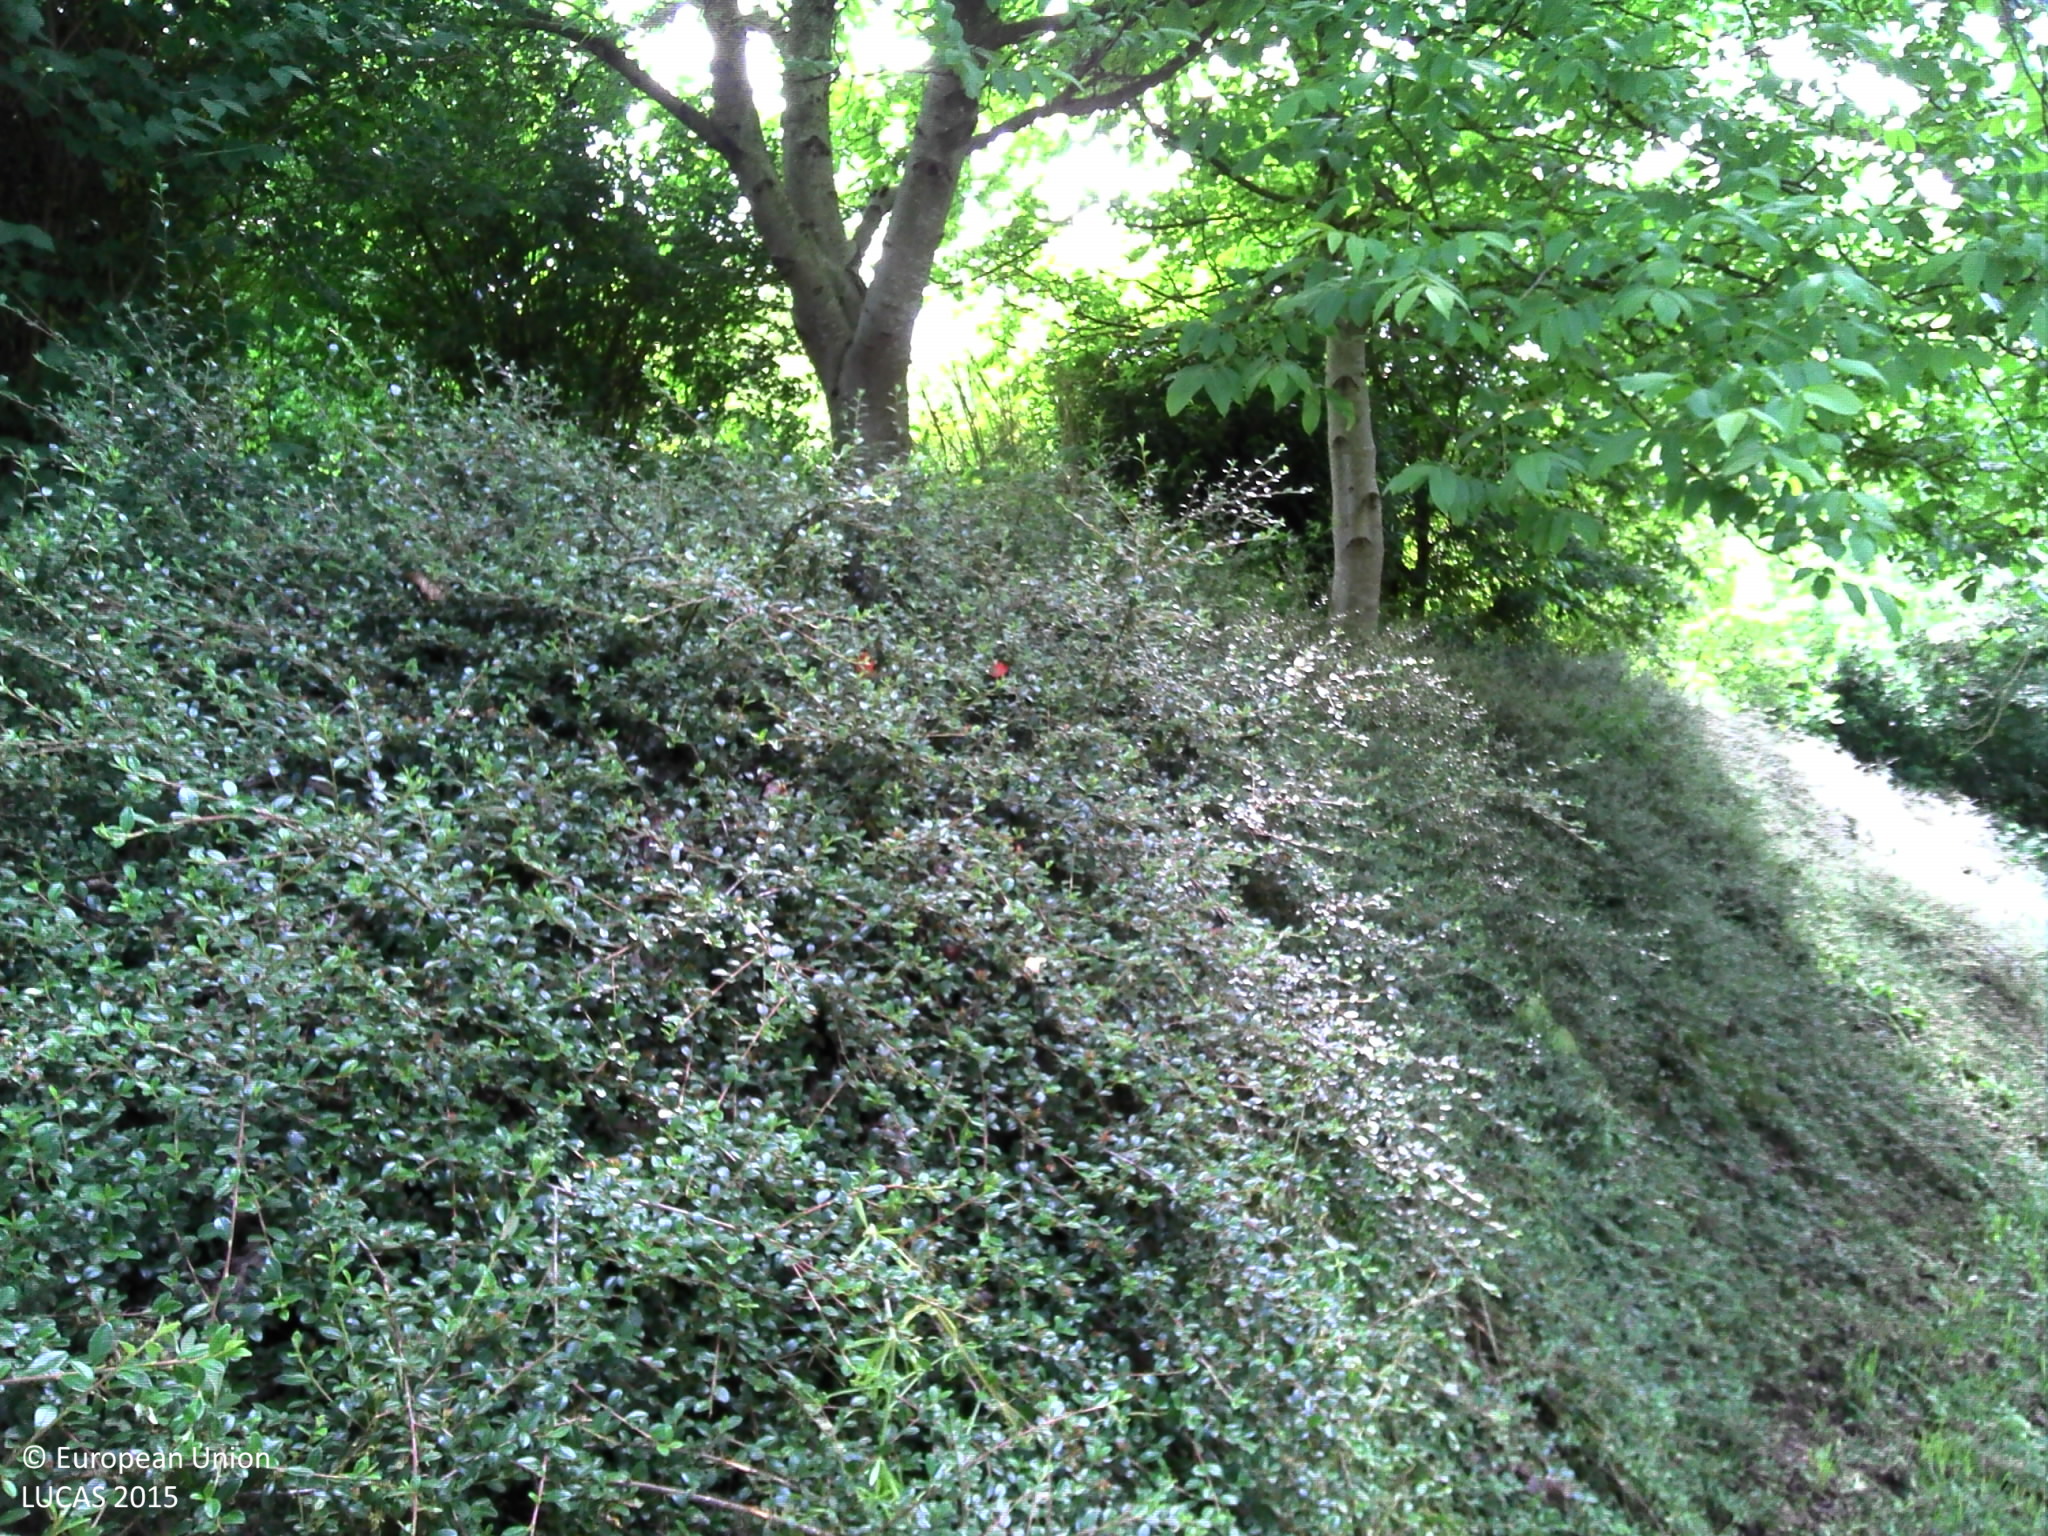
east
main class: Woodland
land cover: Broadleaved woodland
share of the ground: > 75 %
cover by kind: broadleaved forest trees 95 %, shrubs 5 %
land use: Residential
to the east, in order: Broadleaved woodland; Artificial constructions in urban areas; Grassland without tree/shrub cover; Fences; Broadleaved woodland; Electric lines; Paved roads, cycling and walking lanes; Grass margins; Broadleaved woodland; Artificial constructions in urban areas; Rivers and streams; Lines of trees; Fences; Grassland without tree/shrub cover; Fences; Broadleaved woodland; Spruce dominated coniferous woodland
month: June
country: BE
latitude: 50.0354
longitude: 5.3489
